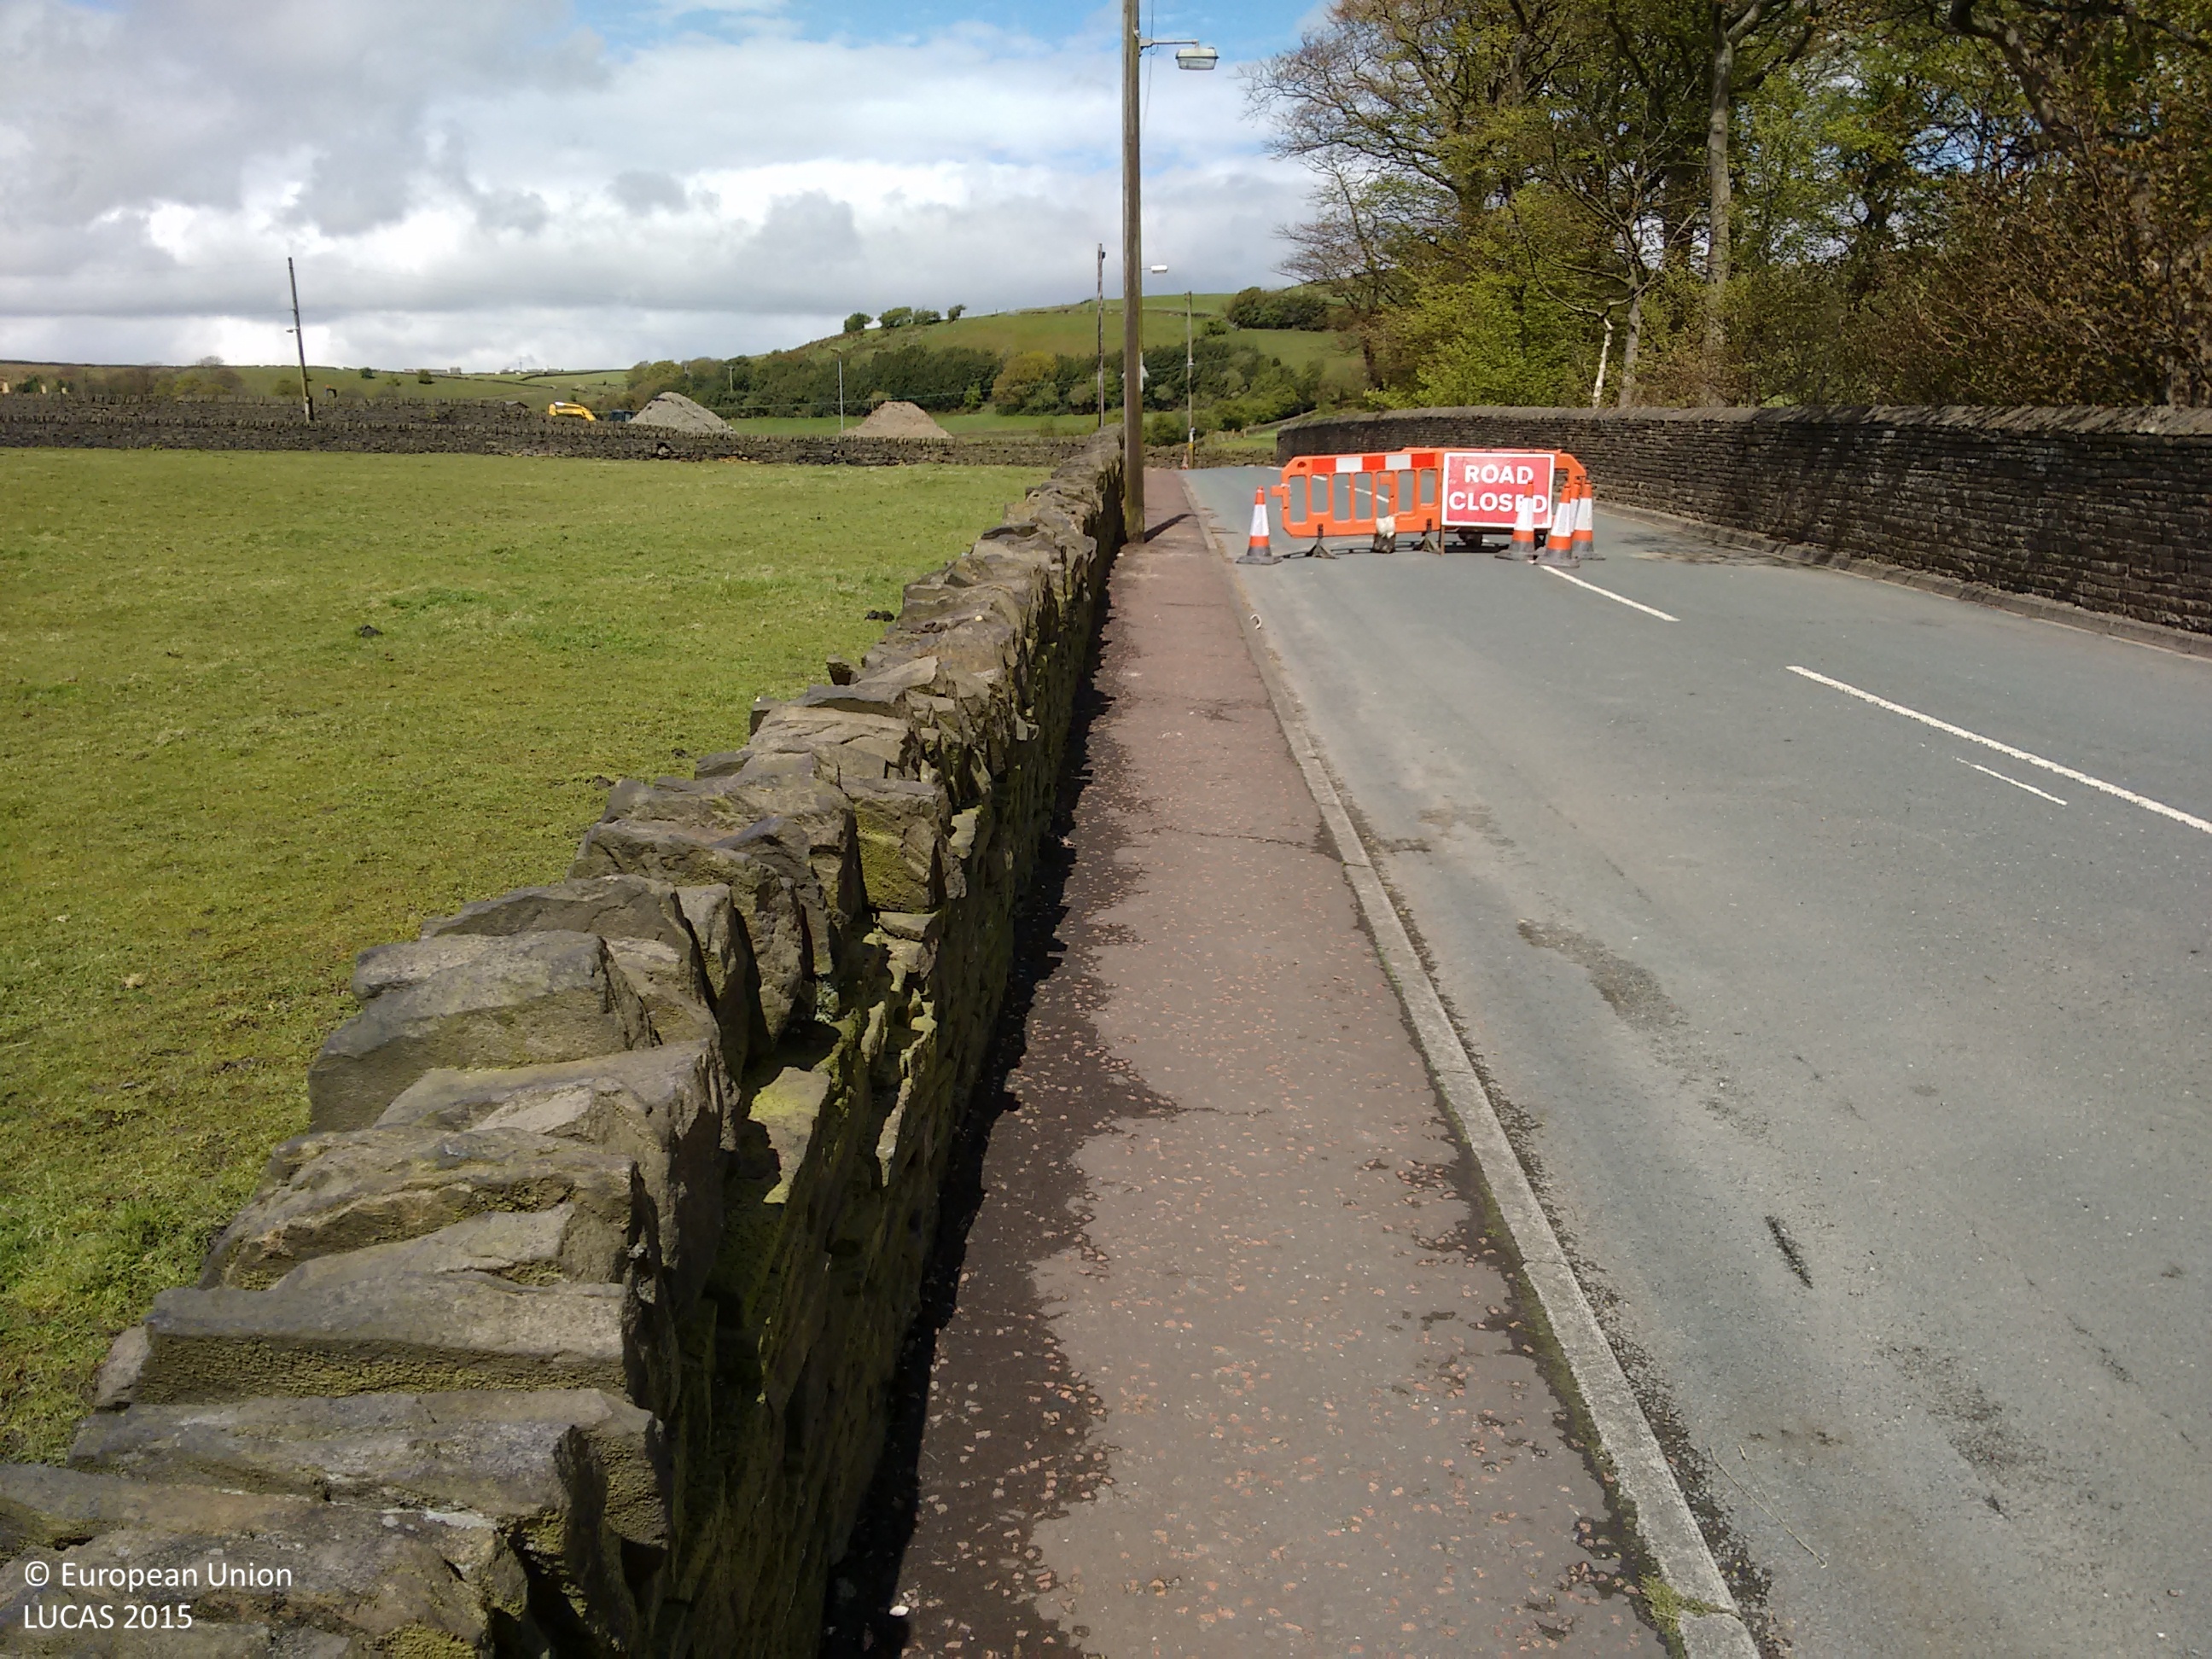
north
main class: Grassland
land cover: Grassland without tree/shrub cover
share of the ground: > 75 %
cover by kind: herbaceous plants 100 %
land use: Agriculture (excluding fallow land and kitchen gardens)
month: May
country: GB
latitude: 53.7462
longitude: -1.8367
